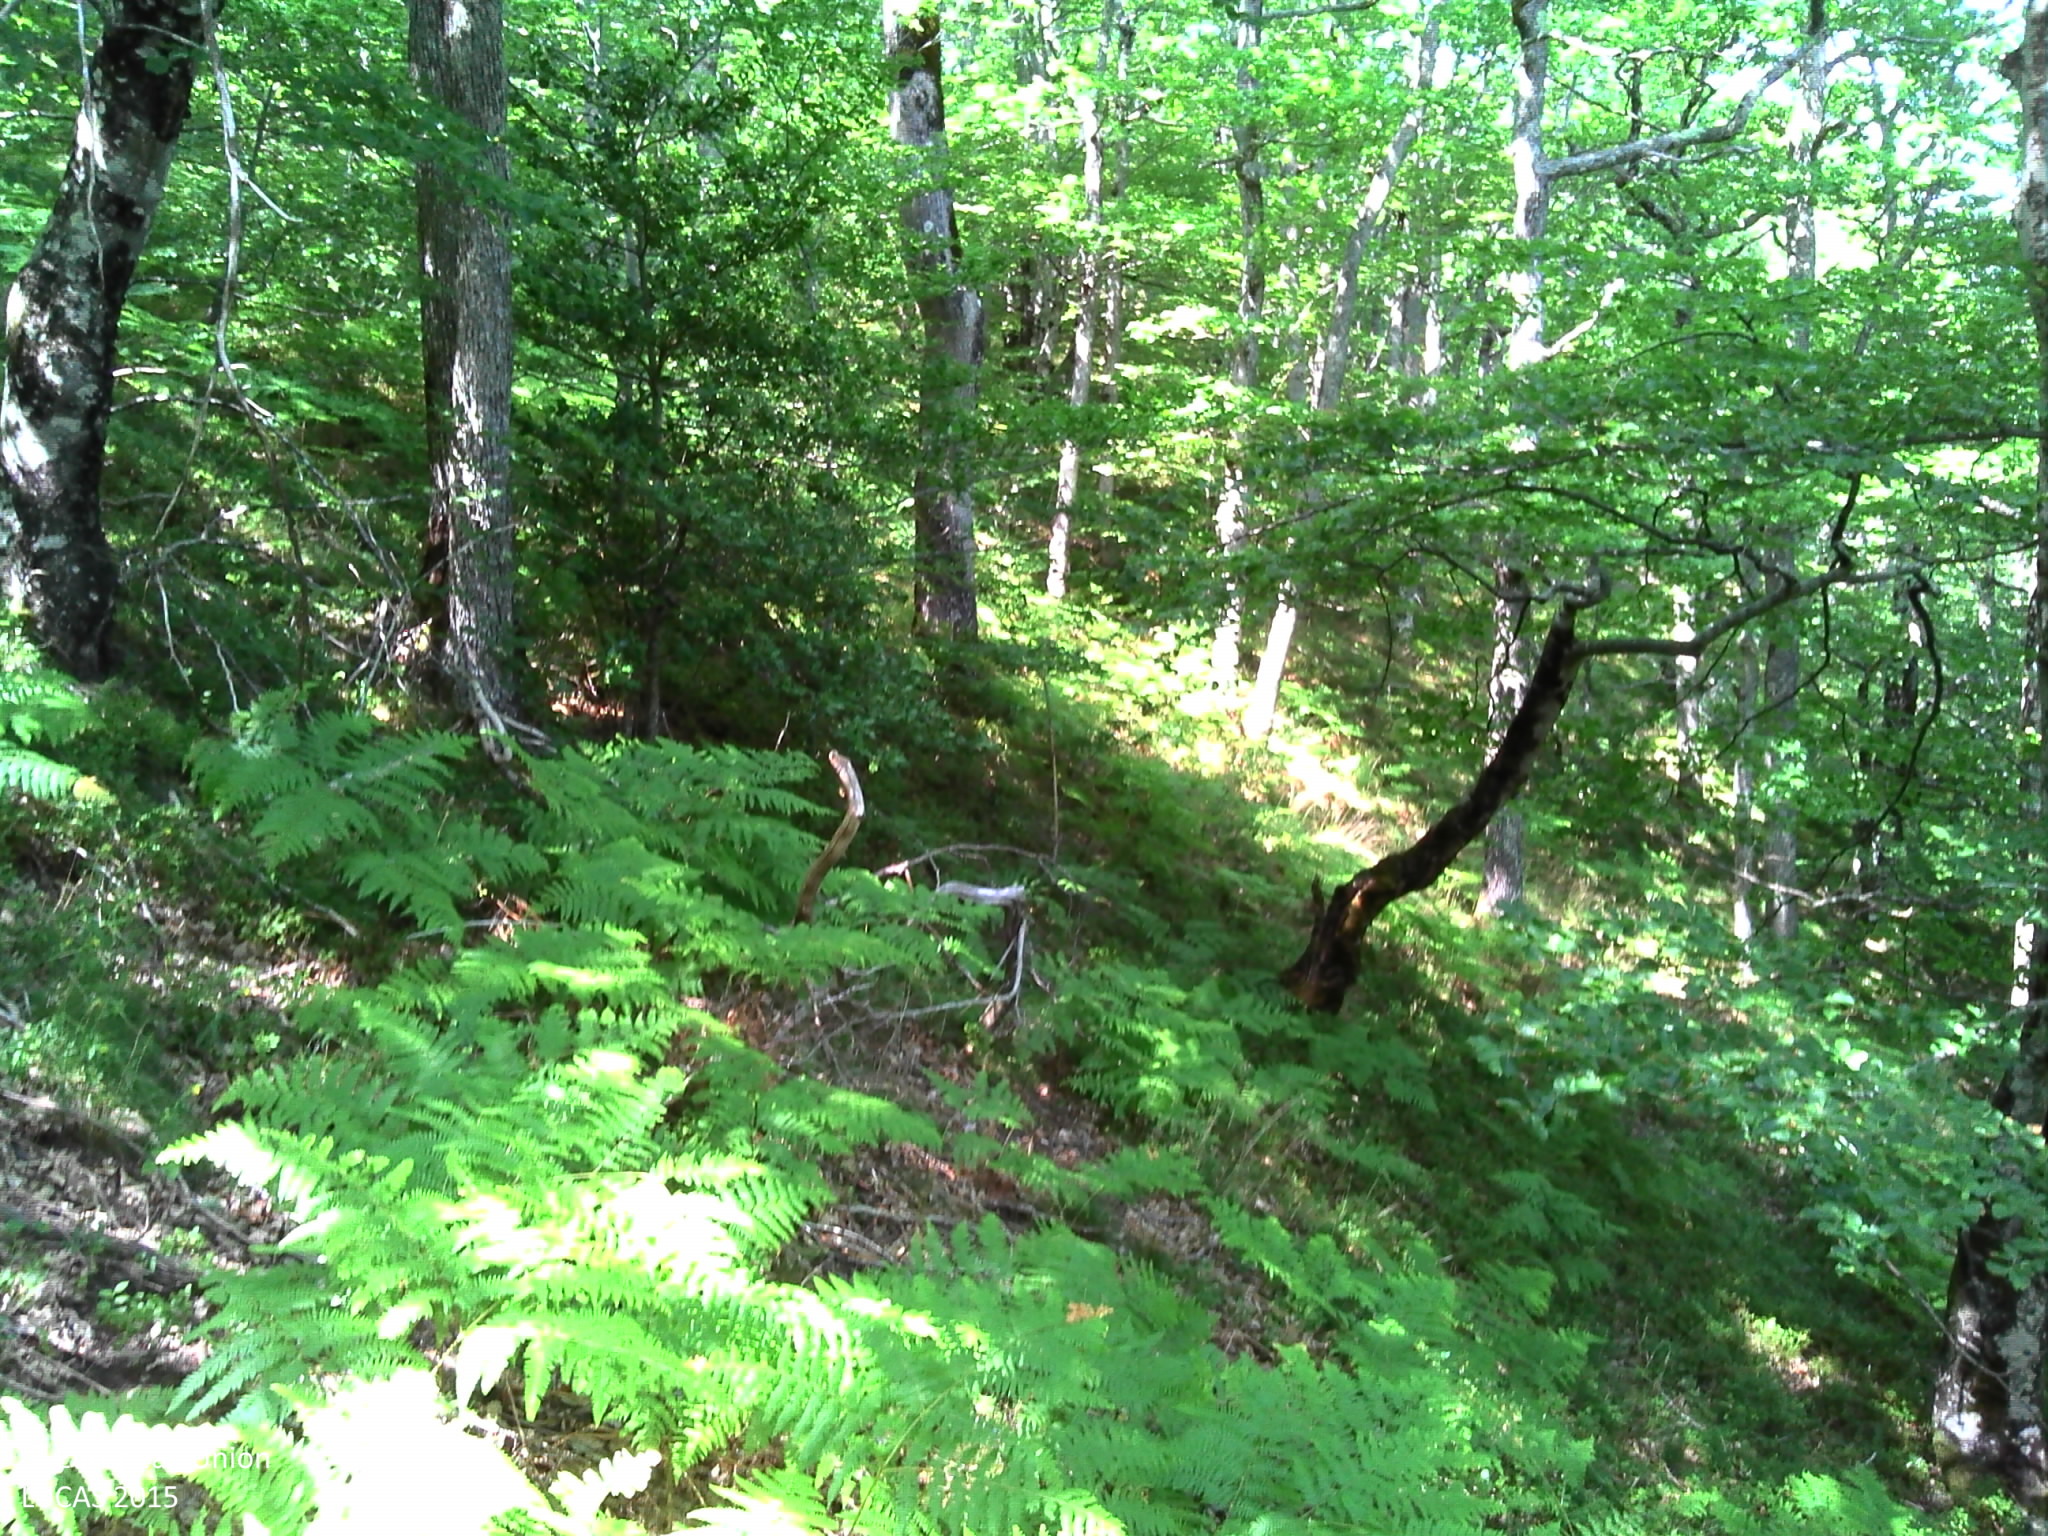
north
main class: Woodland
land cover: Broadleaved woodland
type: acidophilous oak and oak-birch forest
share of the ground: > 75 %
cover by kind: broadleaved forest trees 90 %, shrubs 5 %, herbaceous plants 5 %
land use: Semi-natural and natural areas not in use
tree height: > 5 m
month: July
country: FR
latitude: 44.5299
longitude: 2.9950
